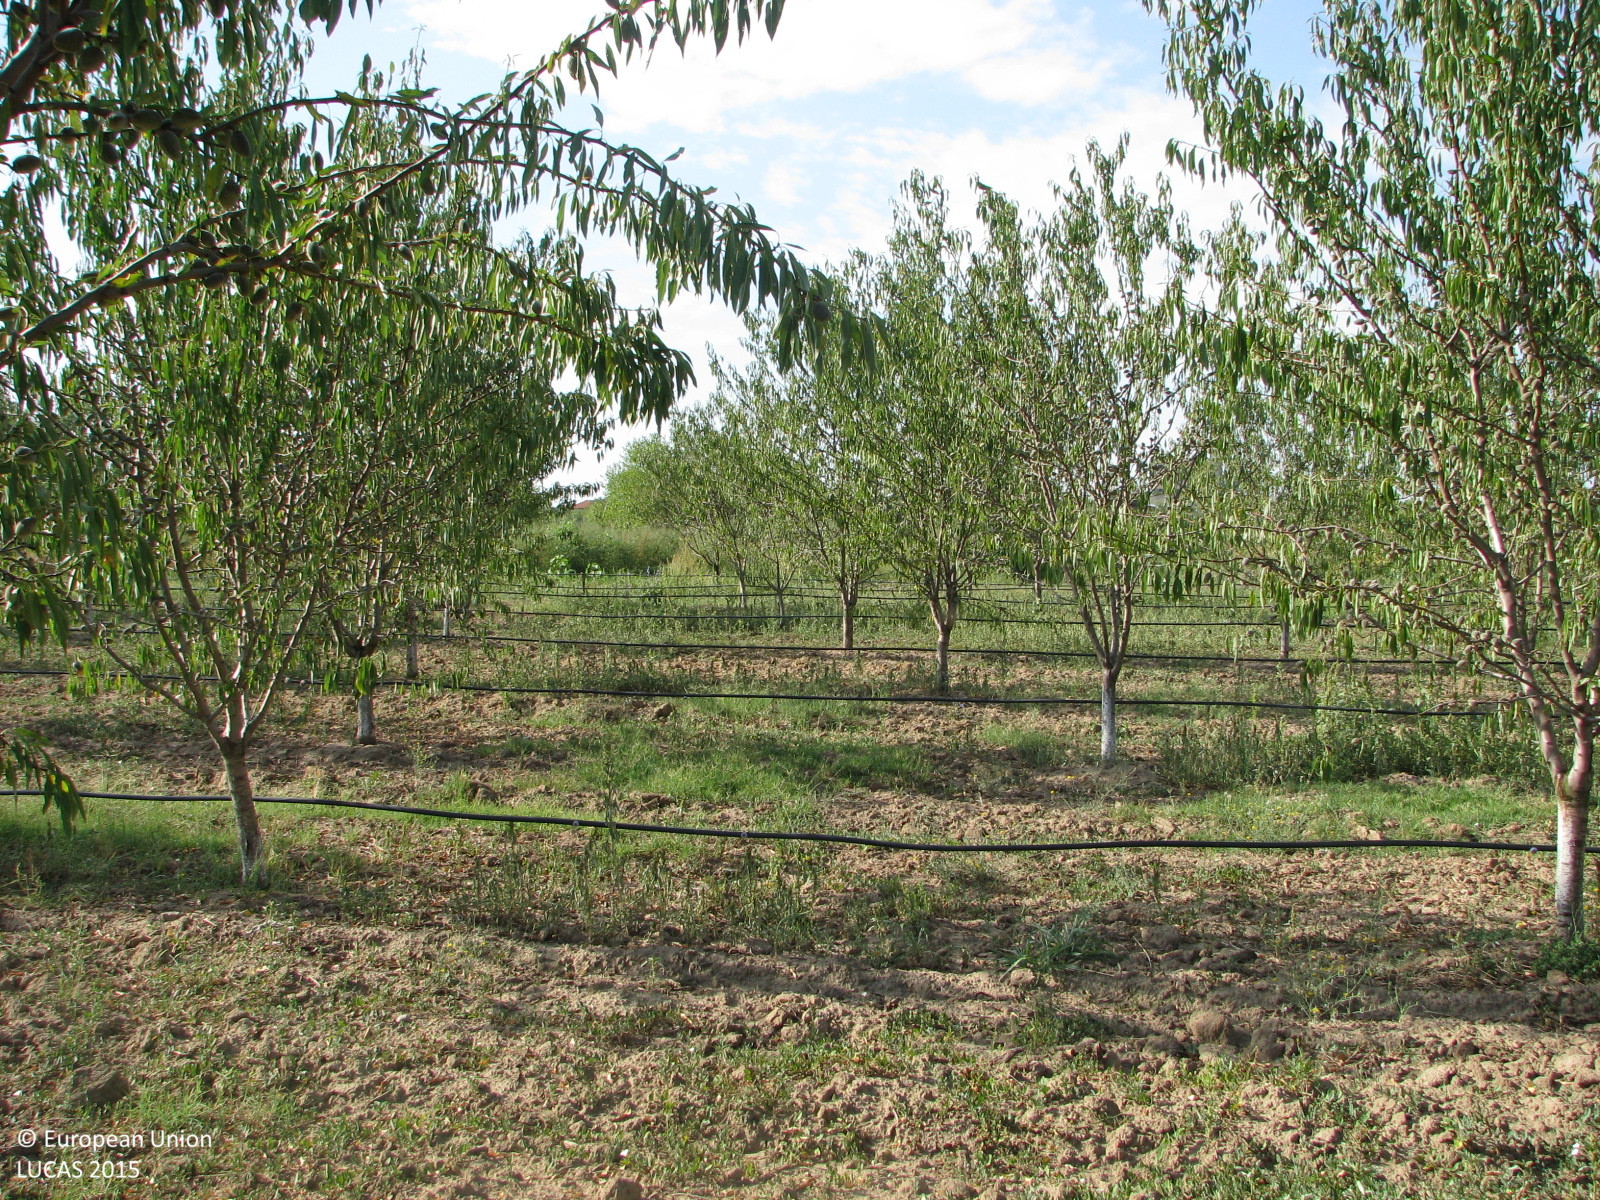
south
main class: Cropland
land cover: Nuts trees
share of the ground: 25 - 50 %
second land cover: Spontaneously vegetated surfaces
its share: 50 - 75 %
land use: Agriculture (excluding fallow land and kitchen gardens)
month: September
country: BG
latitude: 42.5844
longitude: 26.2322
